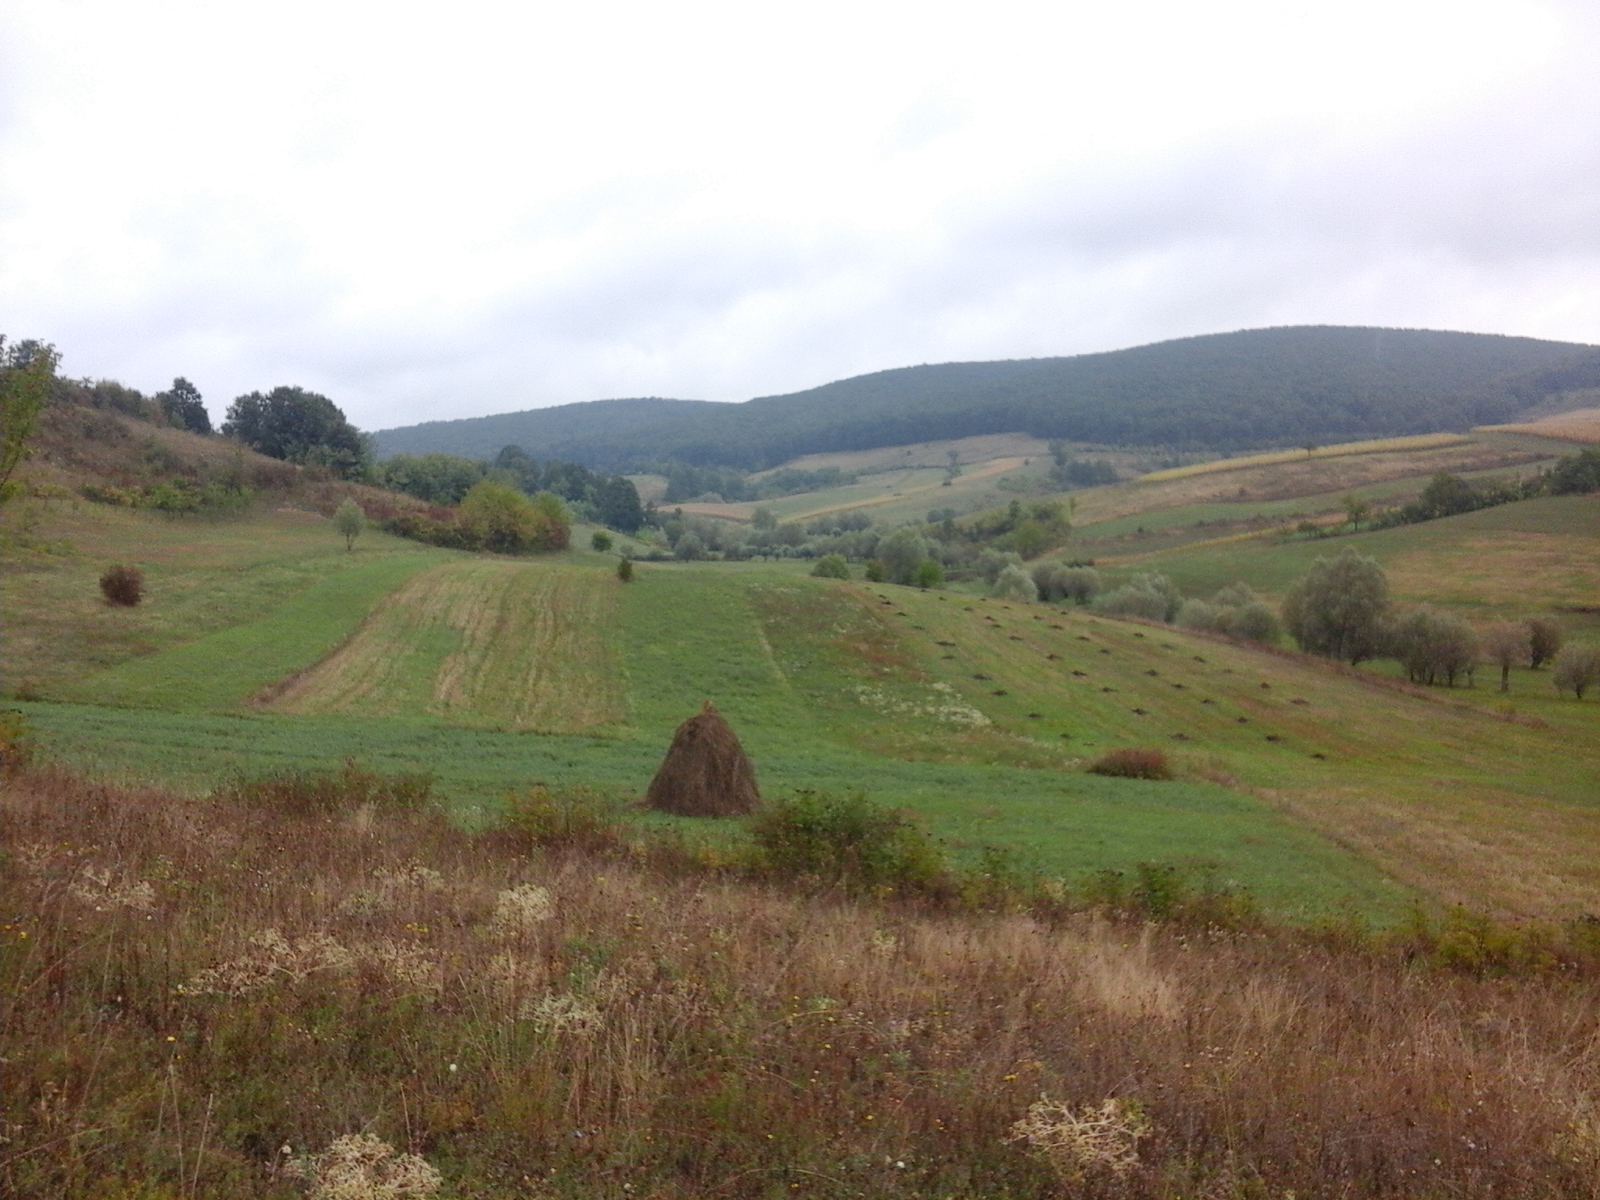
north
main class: Grassland
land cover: Spontaneously vegetated surfaces
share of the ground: > 75 %
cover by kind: herbaceous plants 100 %
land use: Fallow land
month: September
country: RO
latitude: 46.7236
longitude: 22.2034
